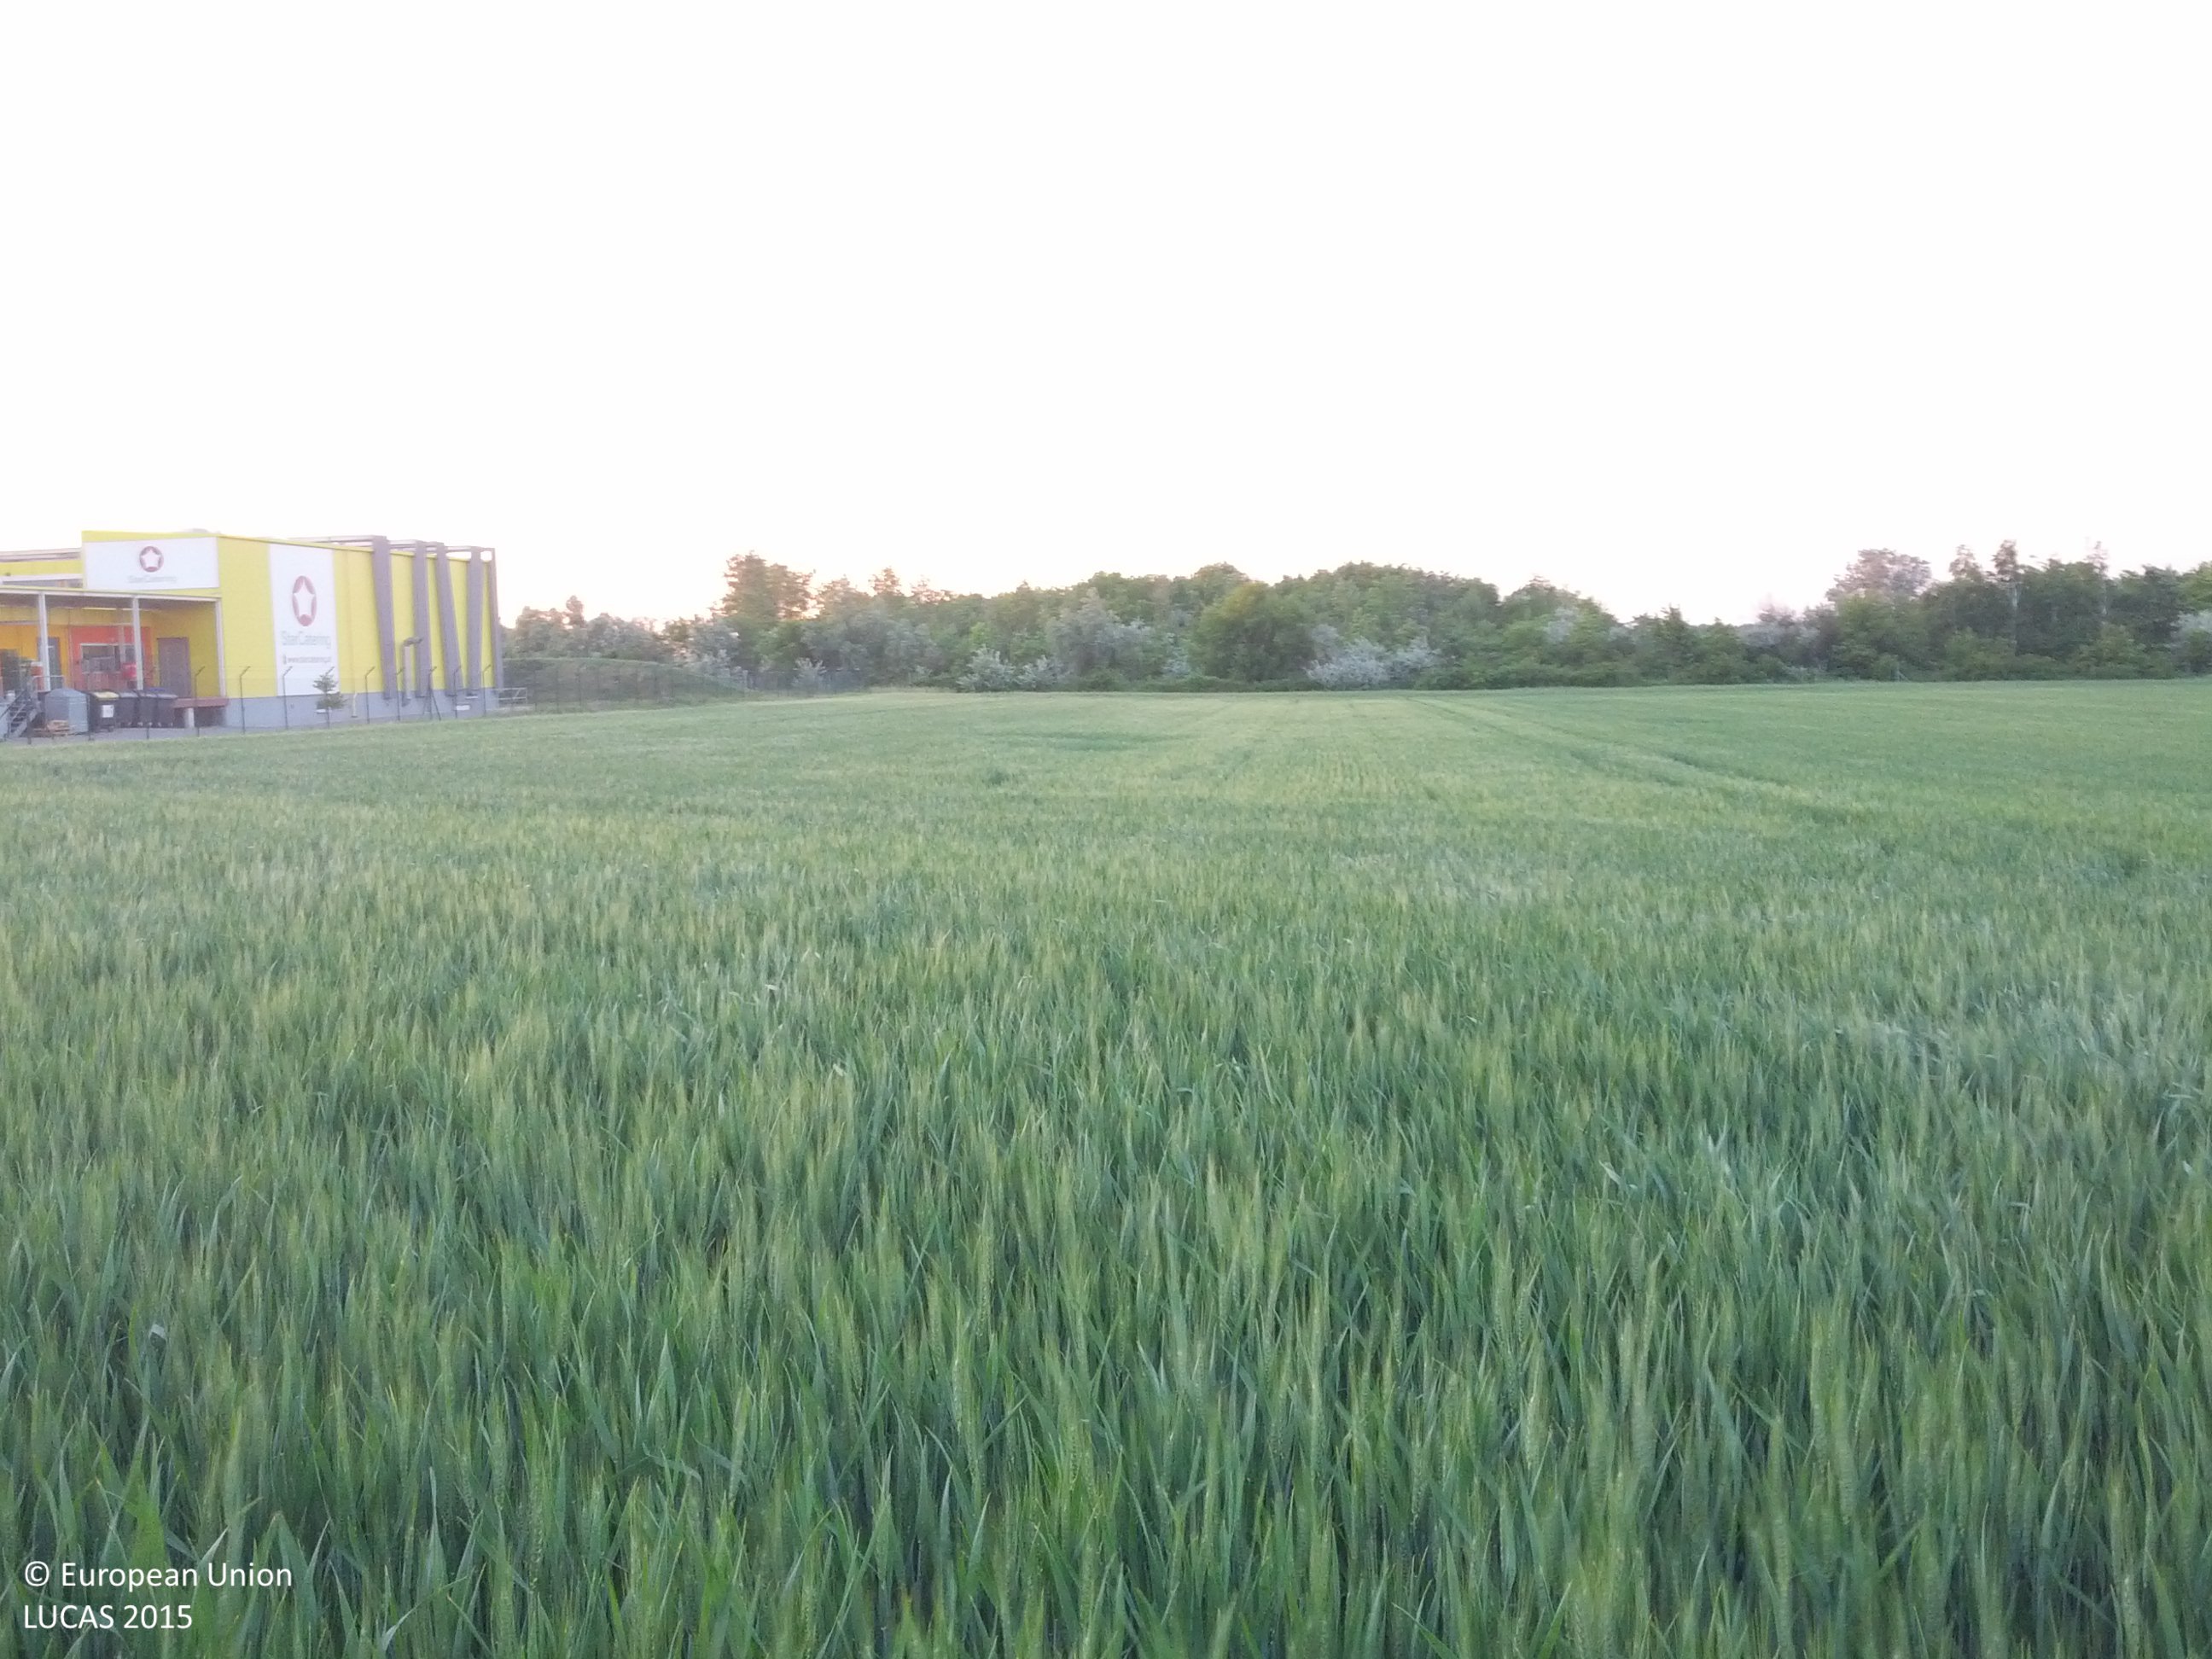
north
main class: Cropland
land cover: Common wheat
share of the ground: > 75 %
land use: Agriculture (excluding fallow land and kitchen gardens)
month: May
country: AT
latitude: 48.1143
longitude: 16.6278
